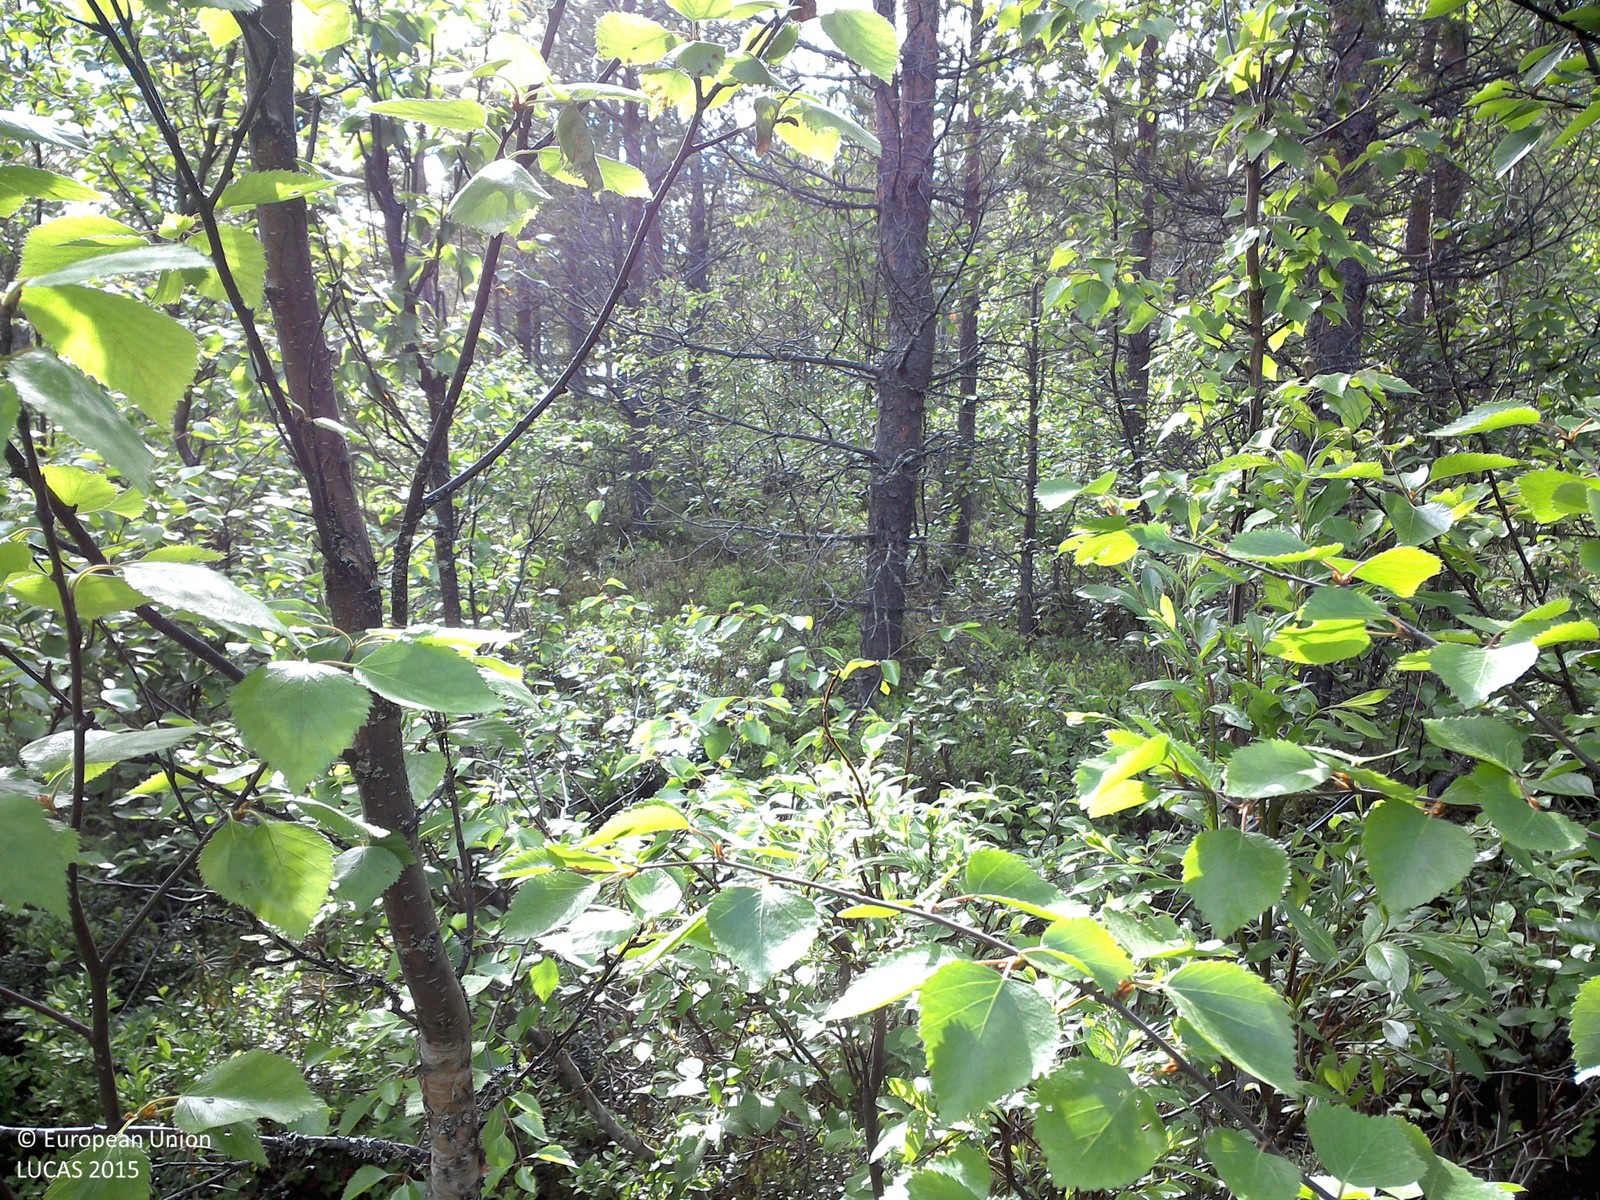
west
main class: Woodland
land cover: Pine dominated mixed woodland
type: boreal forest
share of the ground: 25 - 50 %
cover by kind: shrubs 45 %, coniferous forest trees 30 %, broadleaved forest trees 15 %, herbaceous plants 5 %
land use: Forestry
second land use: Amenities, museums, leisure
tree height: > 5 m
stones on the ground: < 10 %
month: June
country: SE
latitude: 66.6418
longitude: 22.9259
